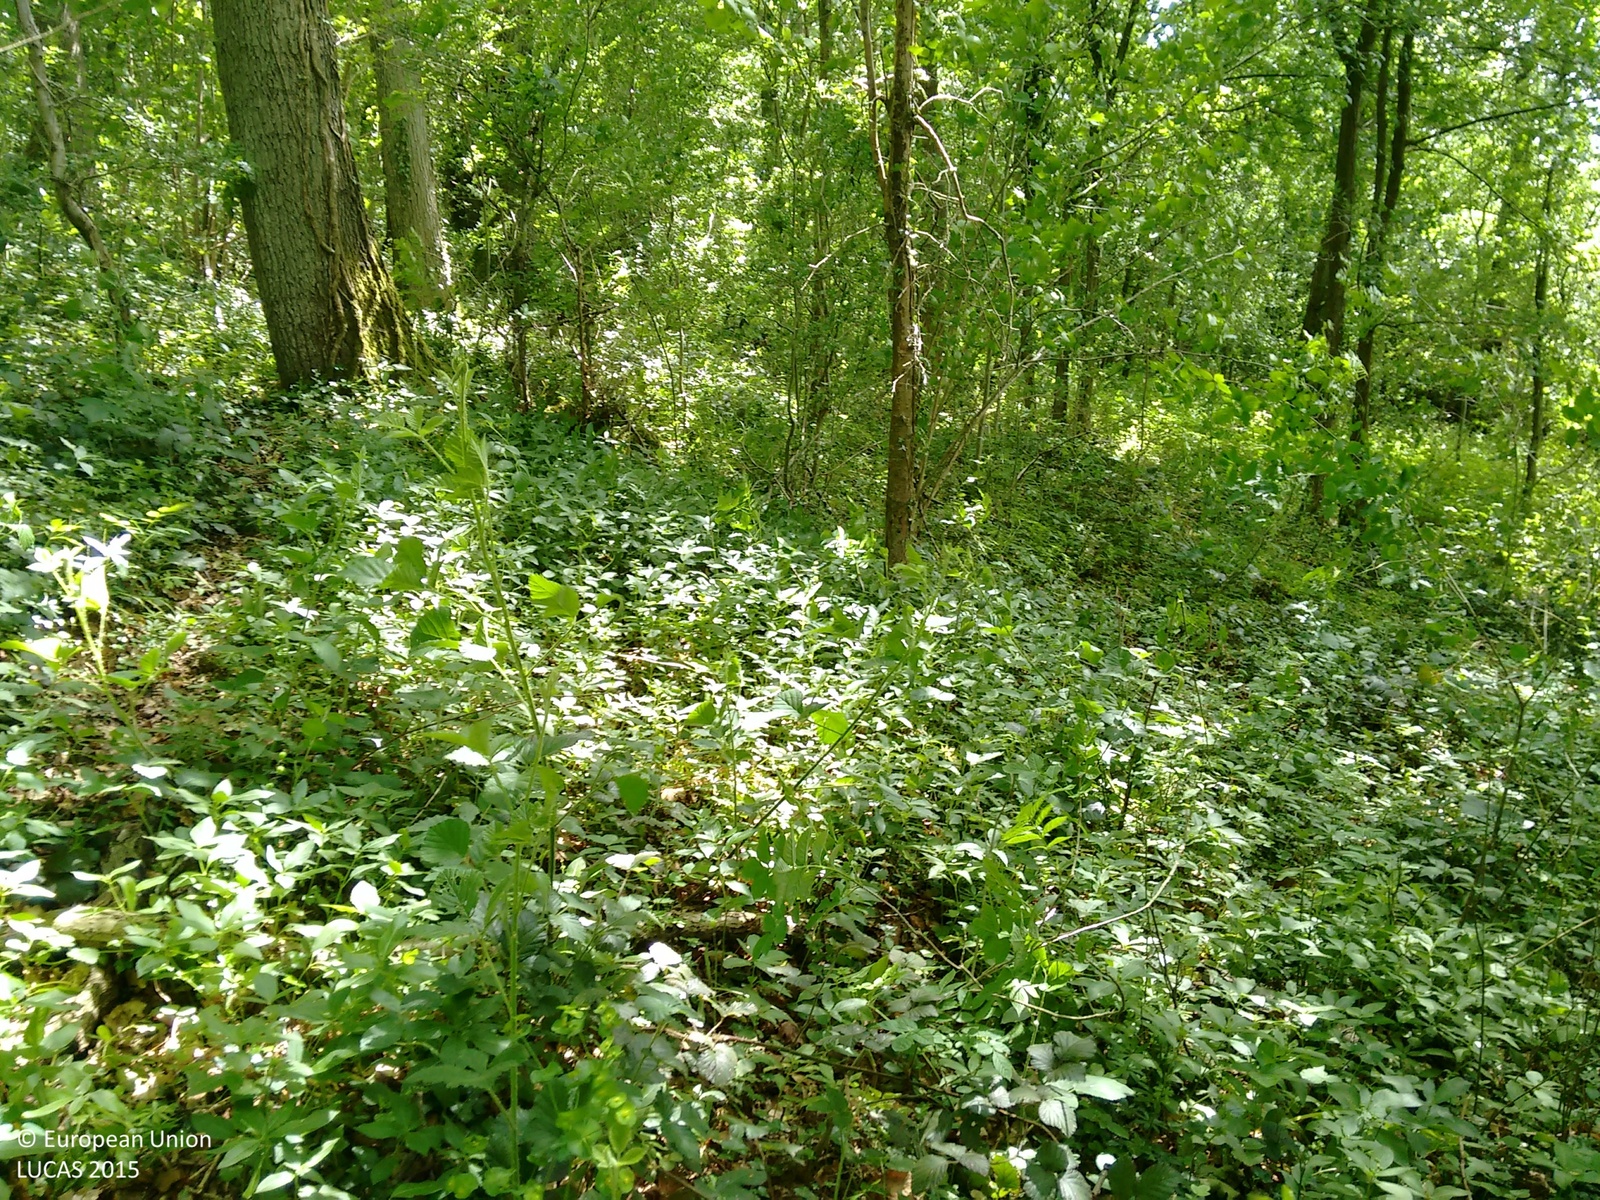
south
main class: Woodland
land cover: Broadleaved woodland
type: mesophytic deciduous forest
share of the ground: > 75 %
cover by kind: broadleaved forest trees 100 %
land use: Semi-natural and natural areas not in use
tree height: > 5 m
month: June
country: GB
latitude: 52.1445
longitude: -2.3833
